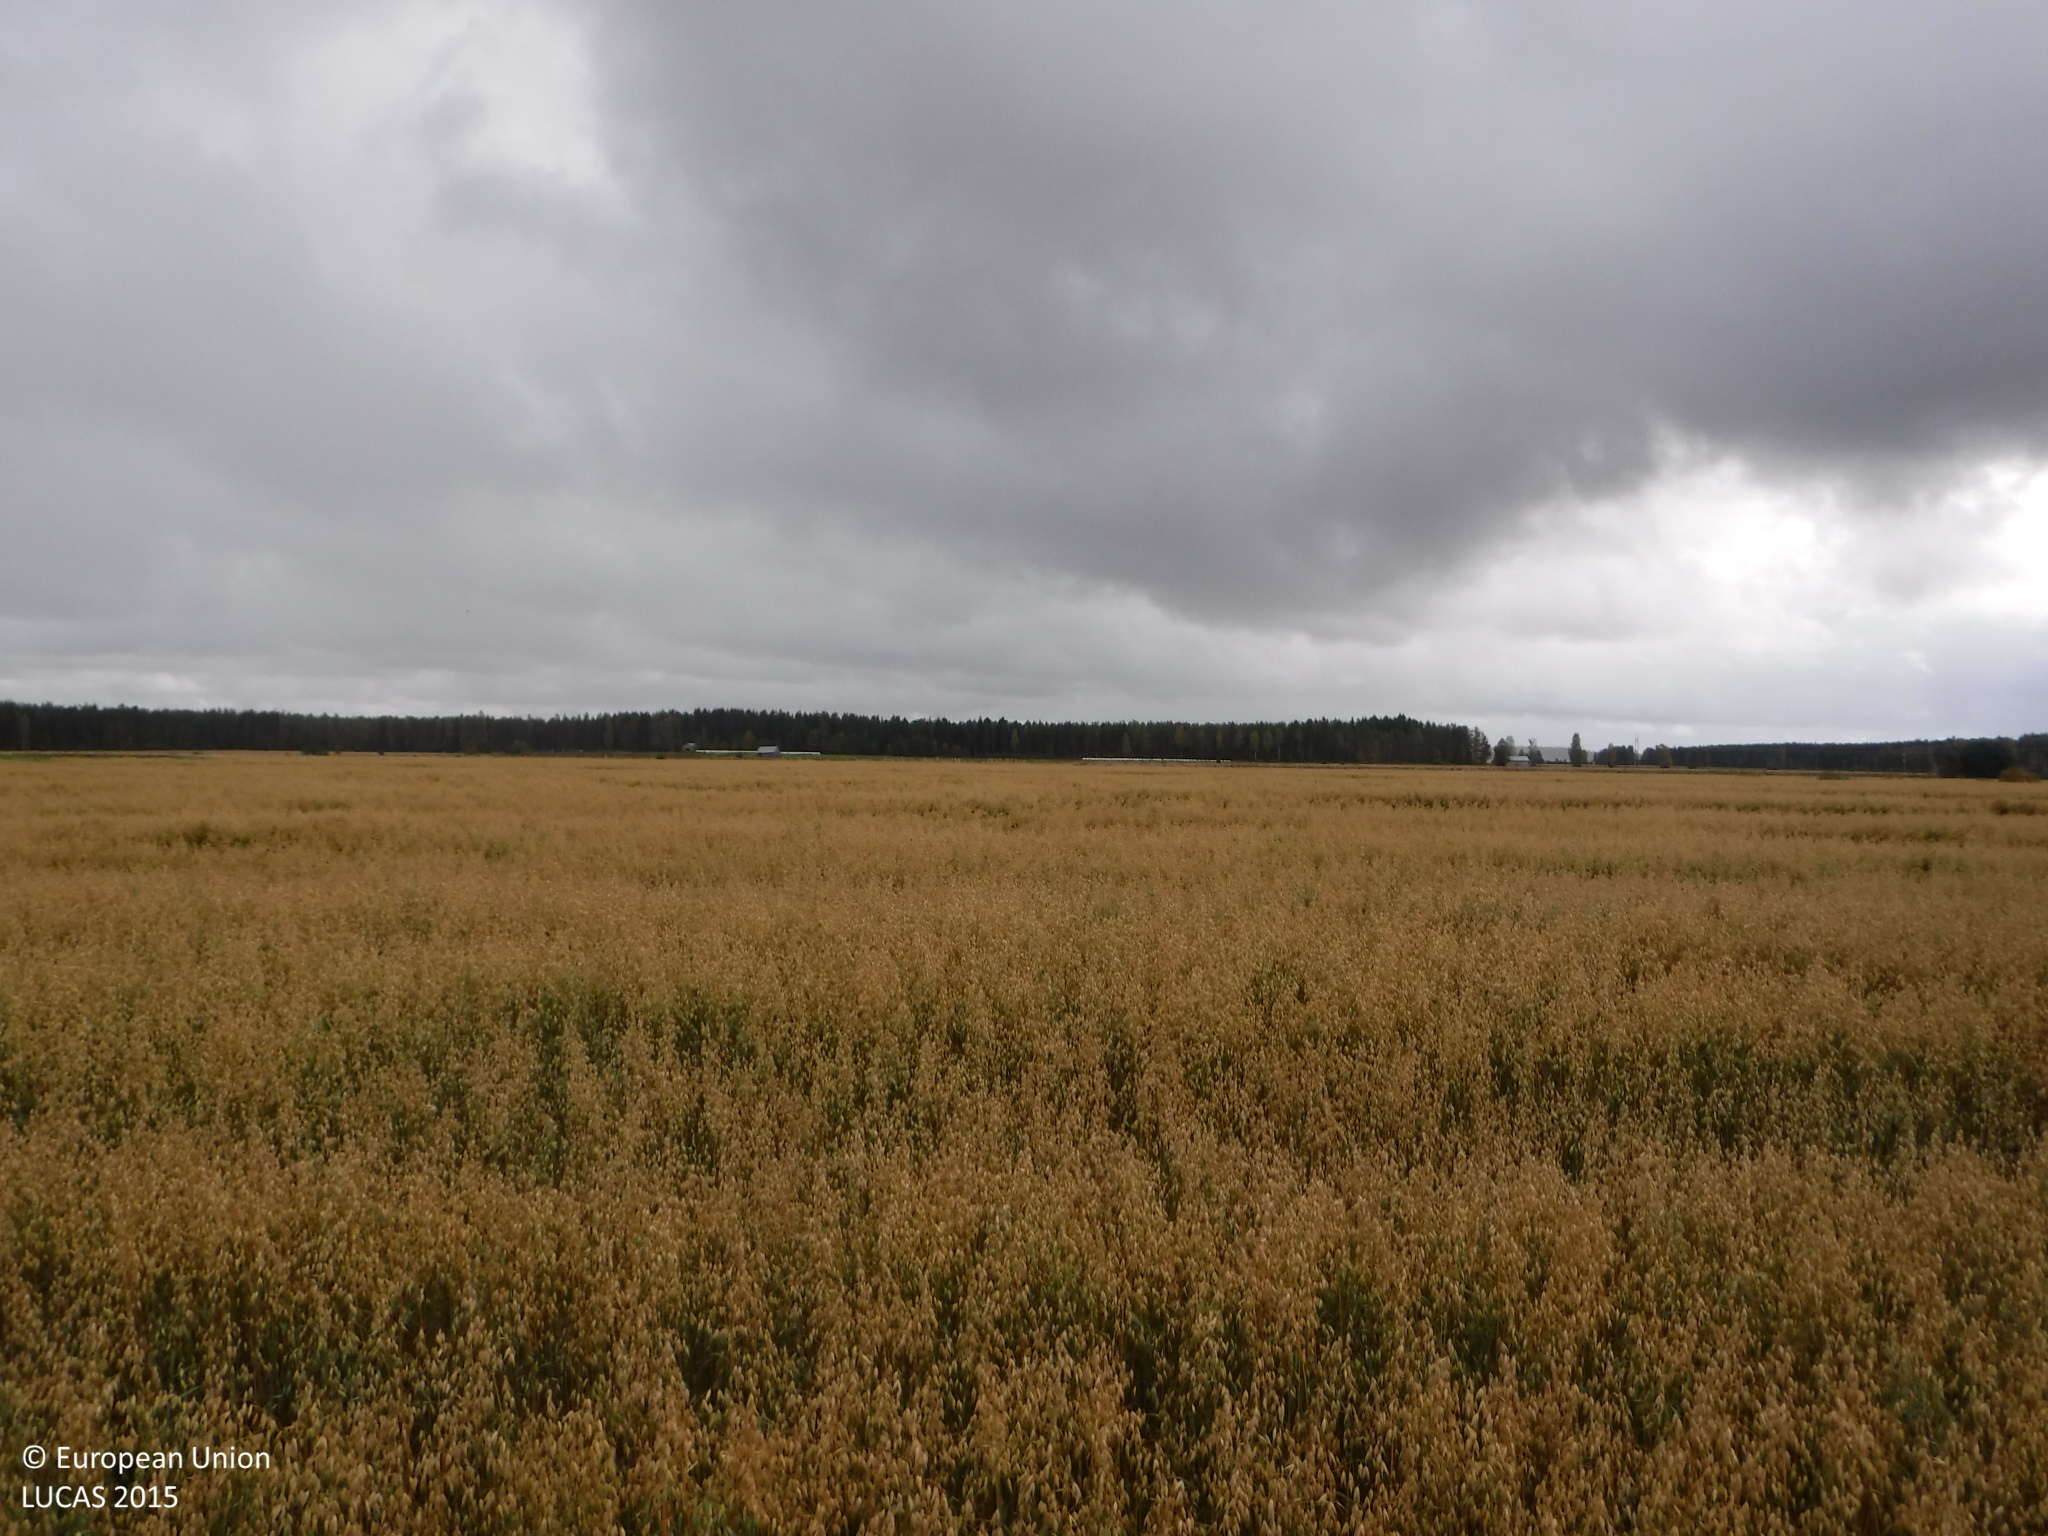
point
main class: Cropland
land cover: Oats
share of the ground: > 75 %
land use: Agriculture (excluding fallow land and kitchen gardens)
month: September
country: FI
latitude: 62.0528
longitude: 22.2783
